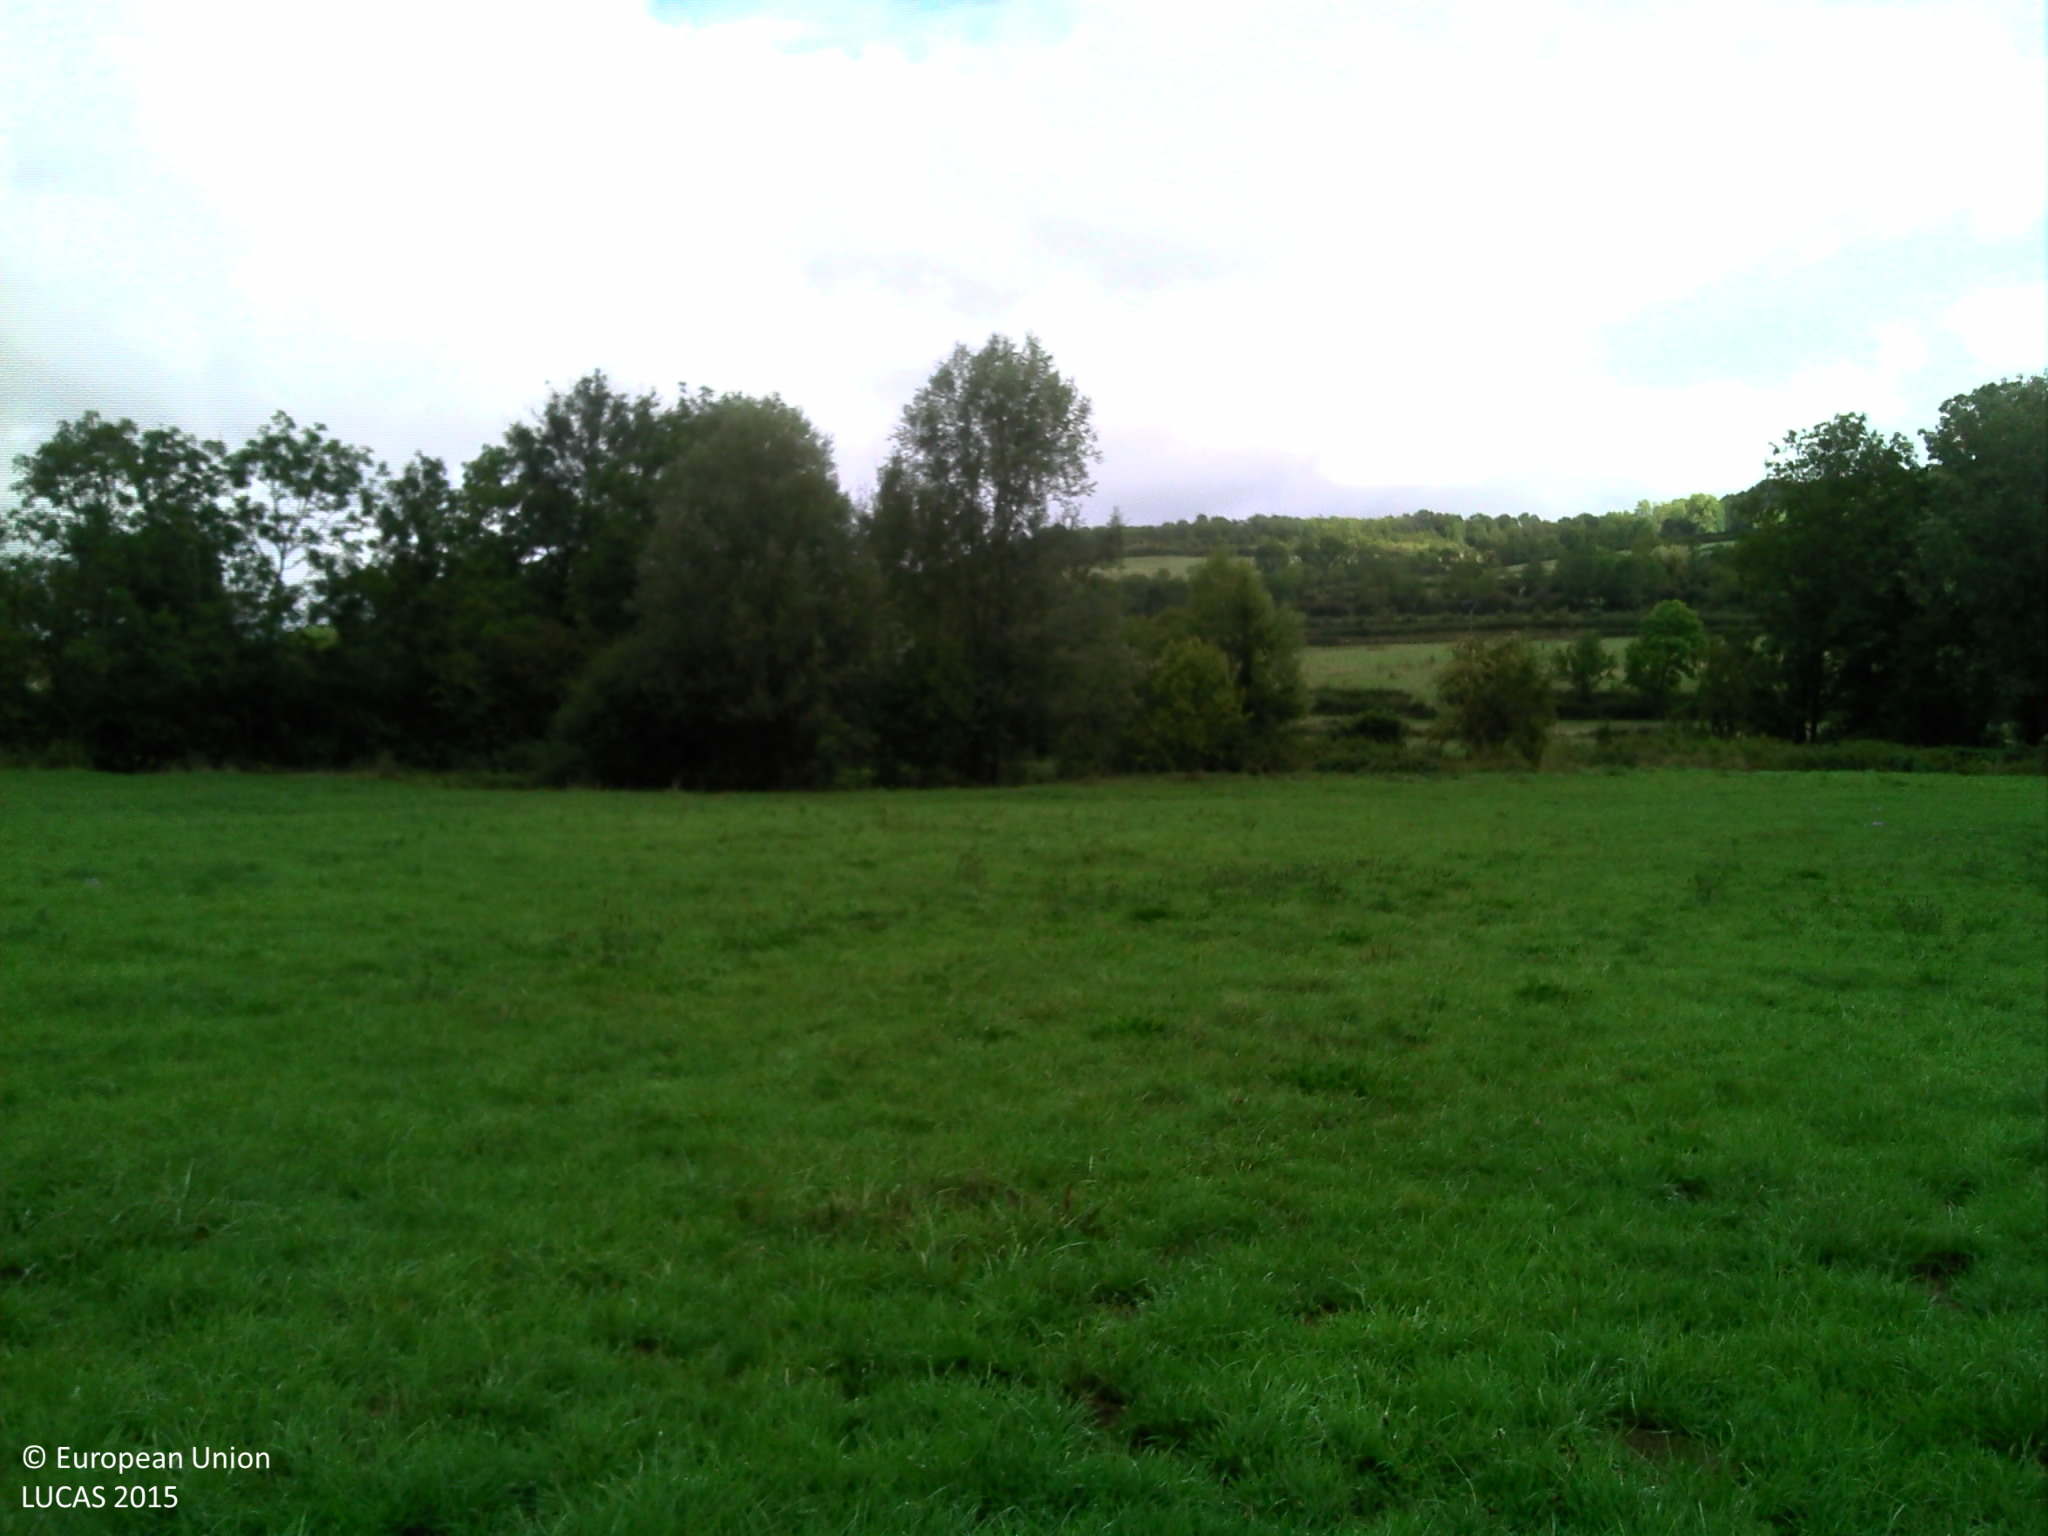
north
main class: Grassland
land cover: Grassland without tree/shrub cover
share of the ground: > 75 %
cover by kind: herbaceous plants 100 %
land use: Agriculture (excluding fallow land and kitchen gardens)
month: September
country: FR
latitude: 47.2339
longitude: 4.4121
